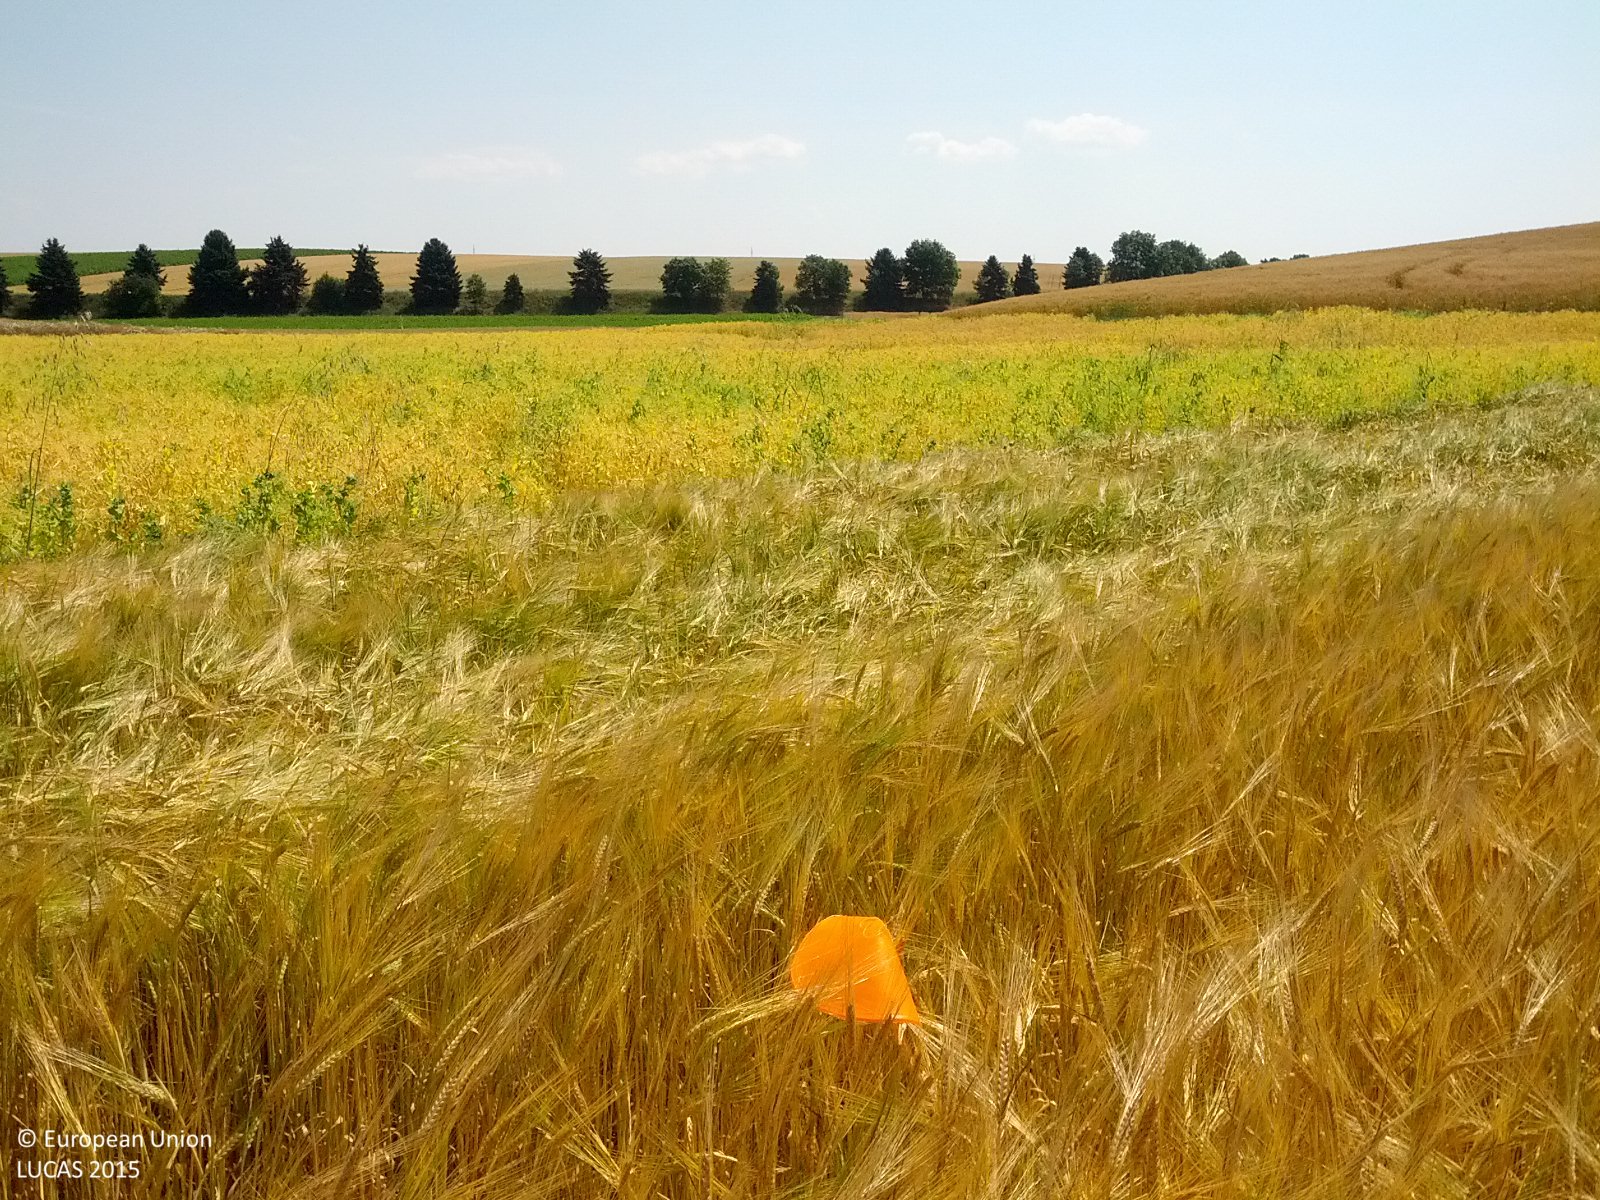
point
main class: Cropland
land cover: Barley
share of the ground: > 75 %
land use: Agriculture (excluding fallow land and kitchen gardens)
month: July
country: AT
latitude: 48.5180
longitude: 16.8172
